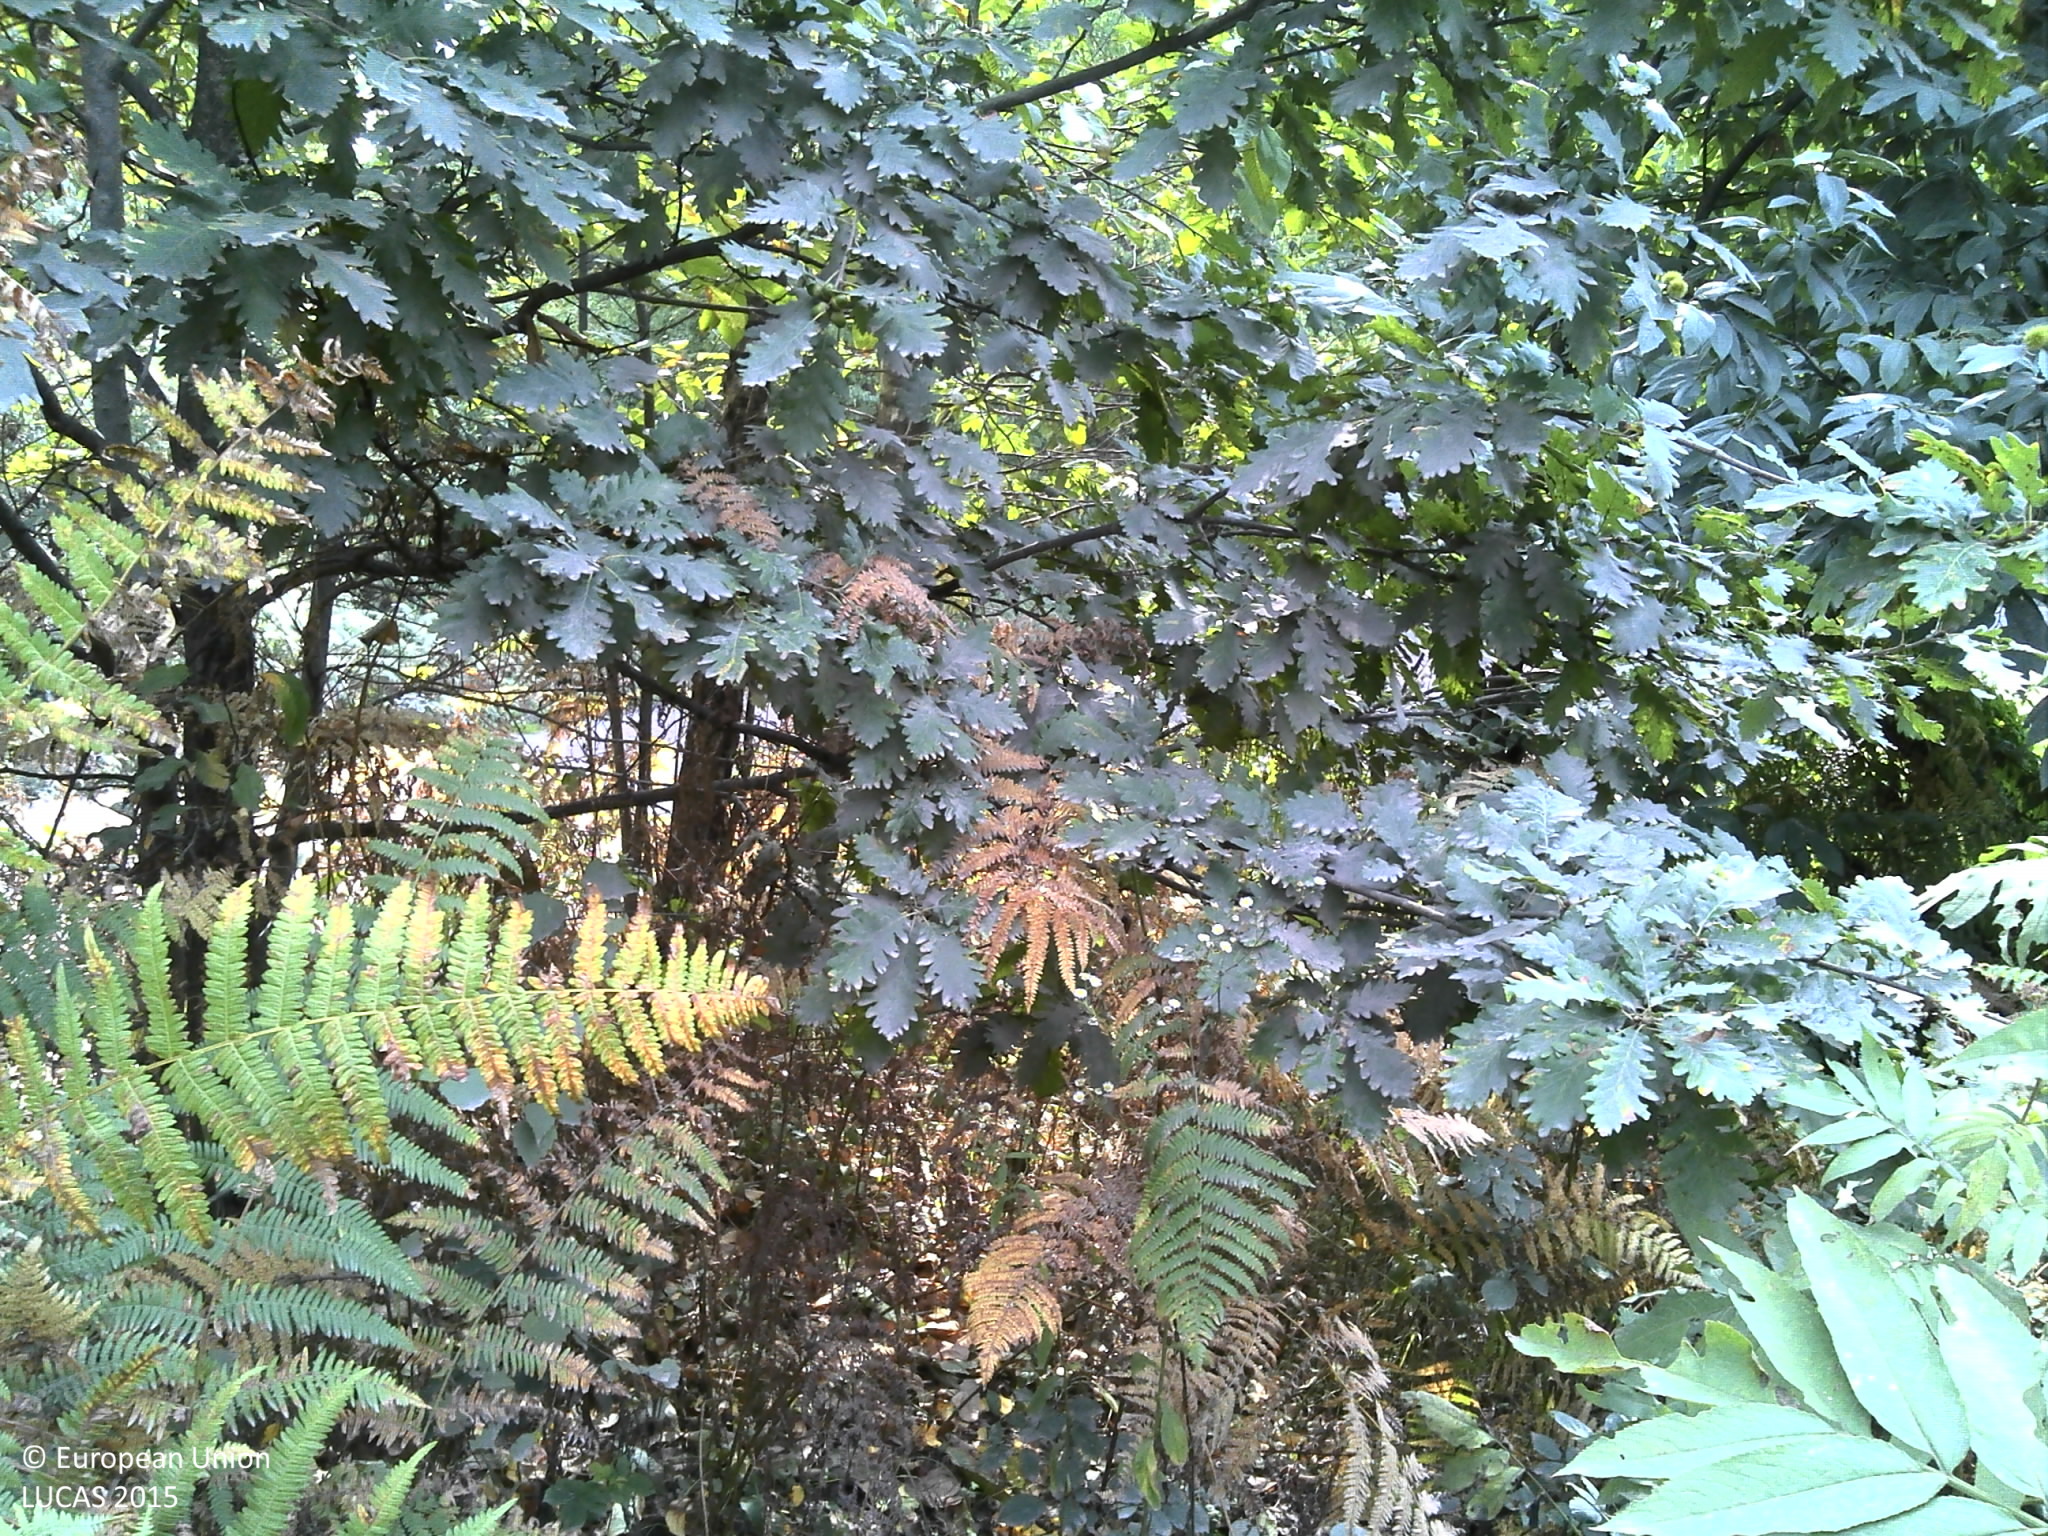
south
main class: Shrubland
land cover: Shrubland with sparse tree cover
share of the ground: > 75 %
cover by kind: shrubs 95 %, broadleaved forest trees 5 %
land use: Forestry
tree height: < 5 m
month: August
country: HR
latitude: 45.2227
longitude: 16.0456
